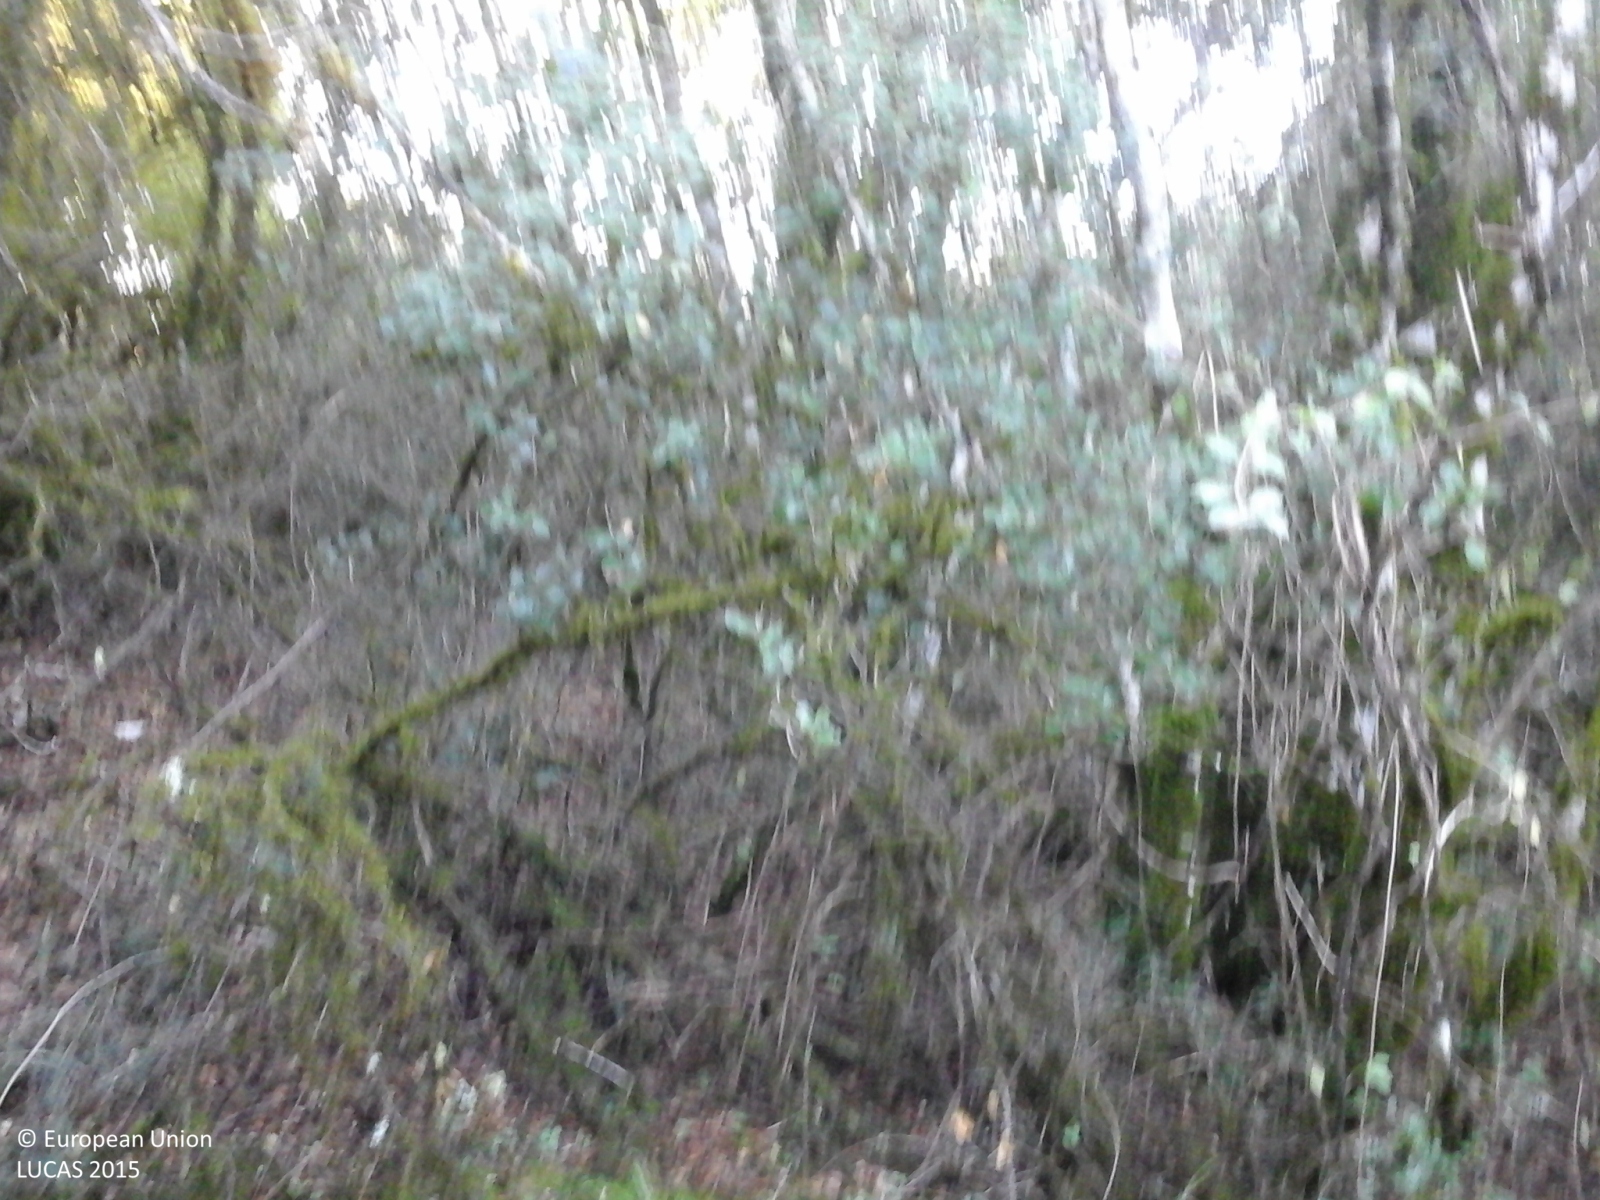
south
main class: Woodland
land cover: Broadleaved woodland
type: broadleaved evergreen forest
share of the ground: 50 - 75 %
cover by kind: broadleaved forest trees 70 %, shrubs 15 %, herbaceous plants 15 %
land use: Semi-natural and natural areas not in use
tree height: > 5 m
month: October
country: GR
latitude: 39.5636
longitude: 20.7668
